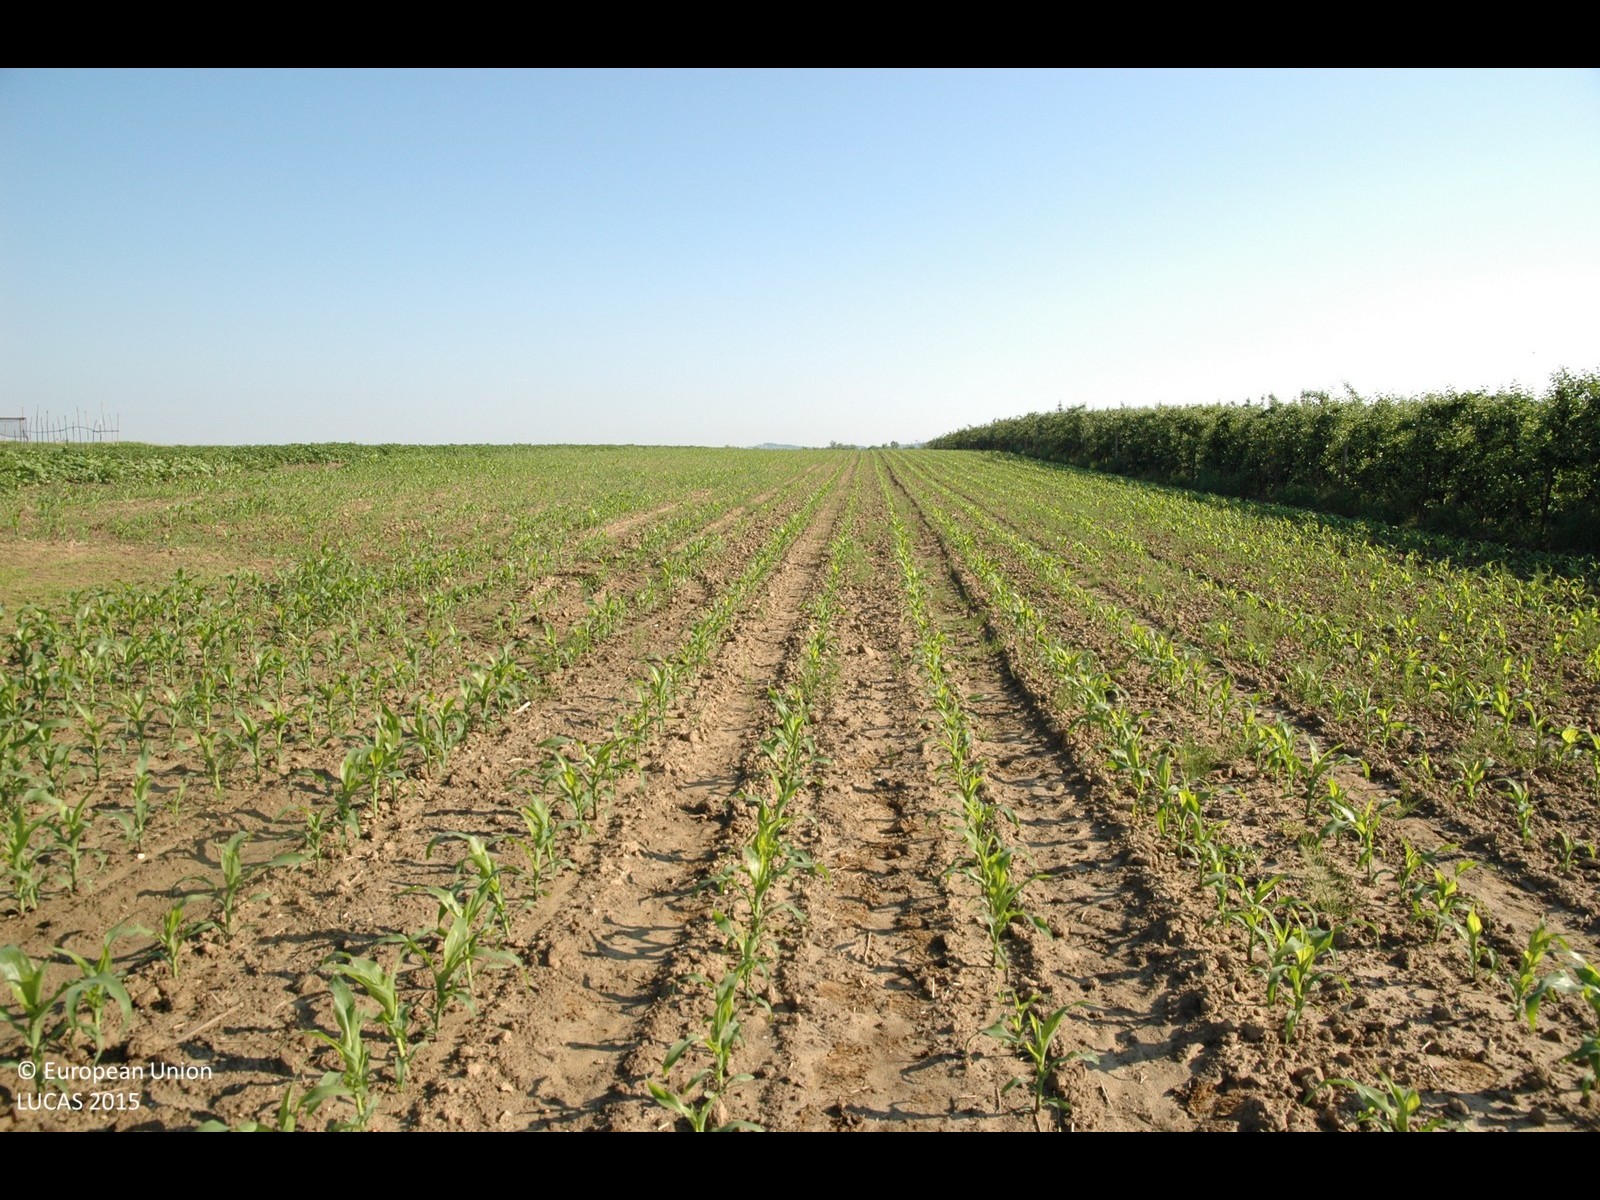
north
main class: Cropland
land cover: Maize
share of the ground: 25 - 50 %
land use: Agriculture (excluding fallow land and kitchen gardens)
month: May
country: HR
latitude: 46.4981
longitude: 16.4769
